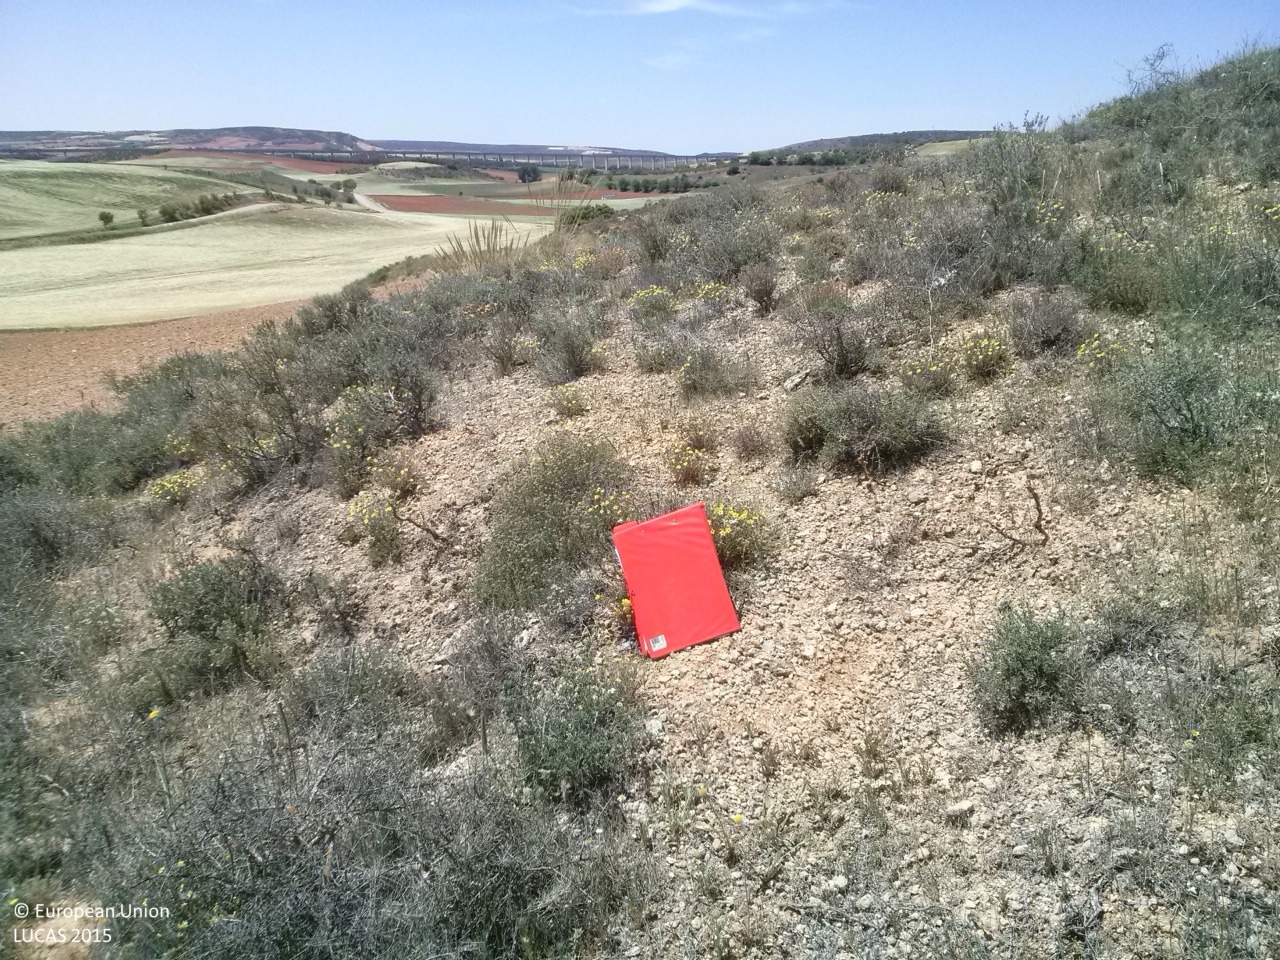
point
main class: Shrubland
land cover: Shrubland without tree cover
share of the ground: 50 - 75 %
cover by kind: shrubs 40 %, herbaceous plants 30 %, unconsolidated bare surface 30 %
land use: Semi-natural and natural areas not in use
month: May
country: ES
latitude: 40.0845
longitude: -2.7939
